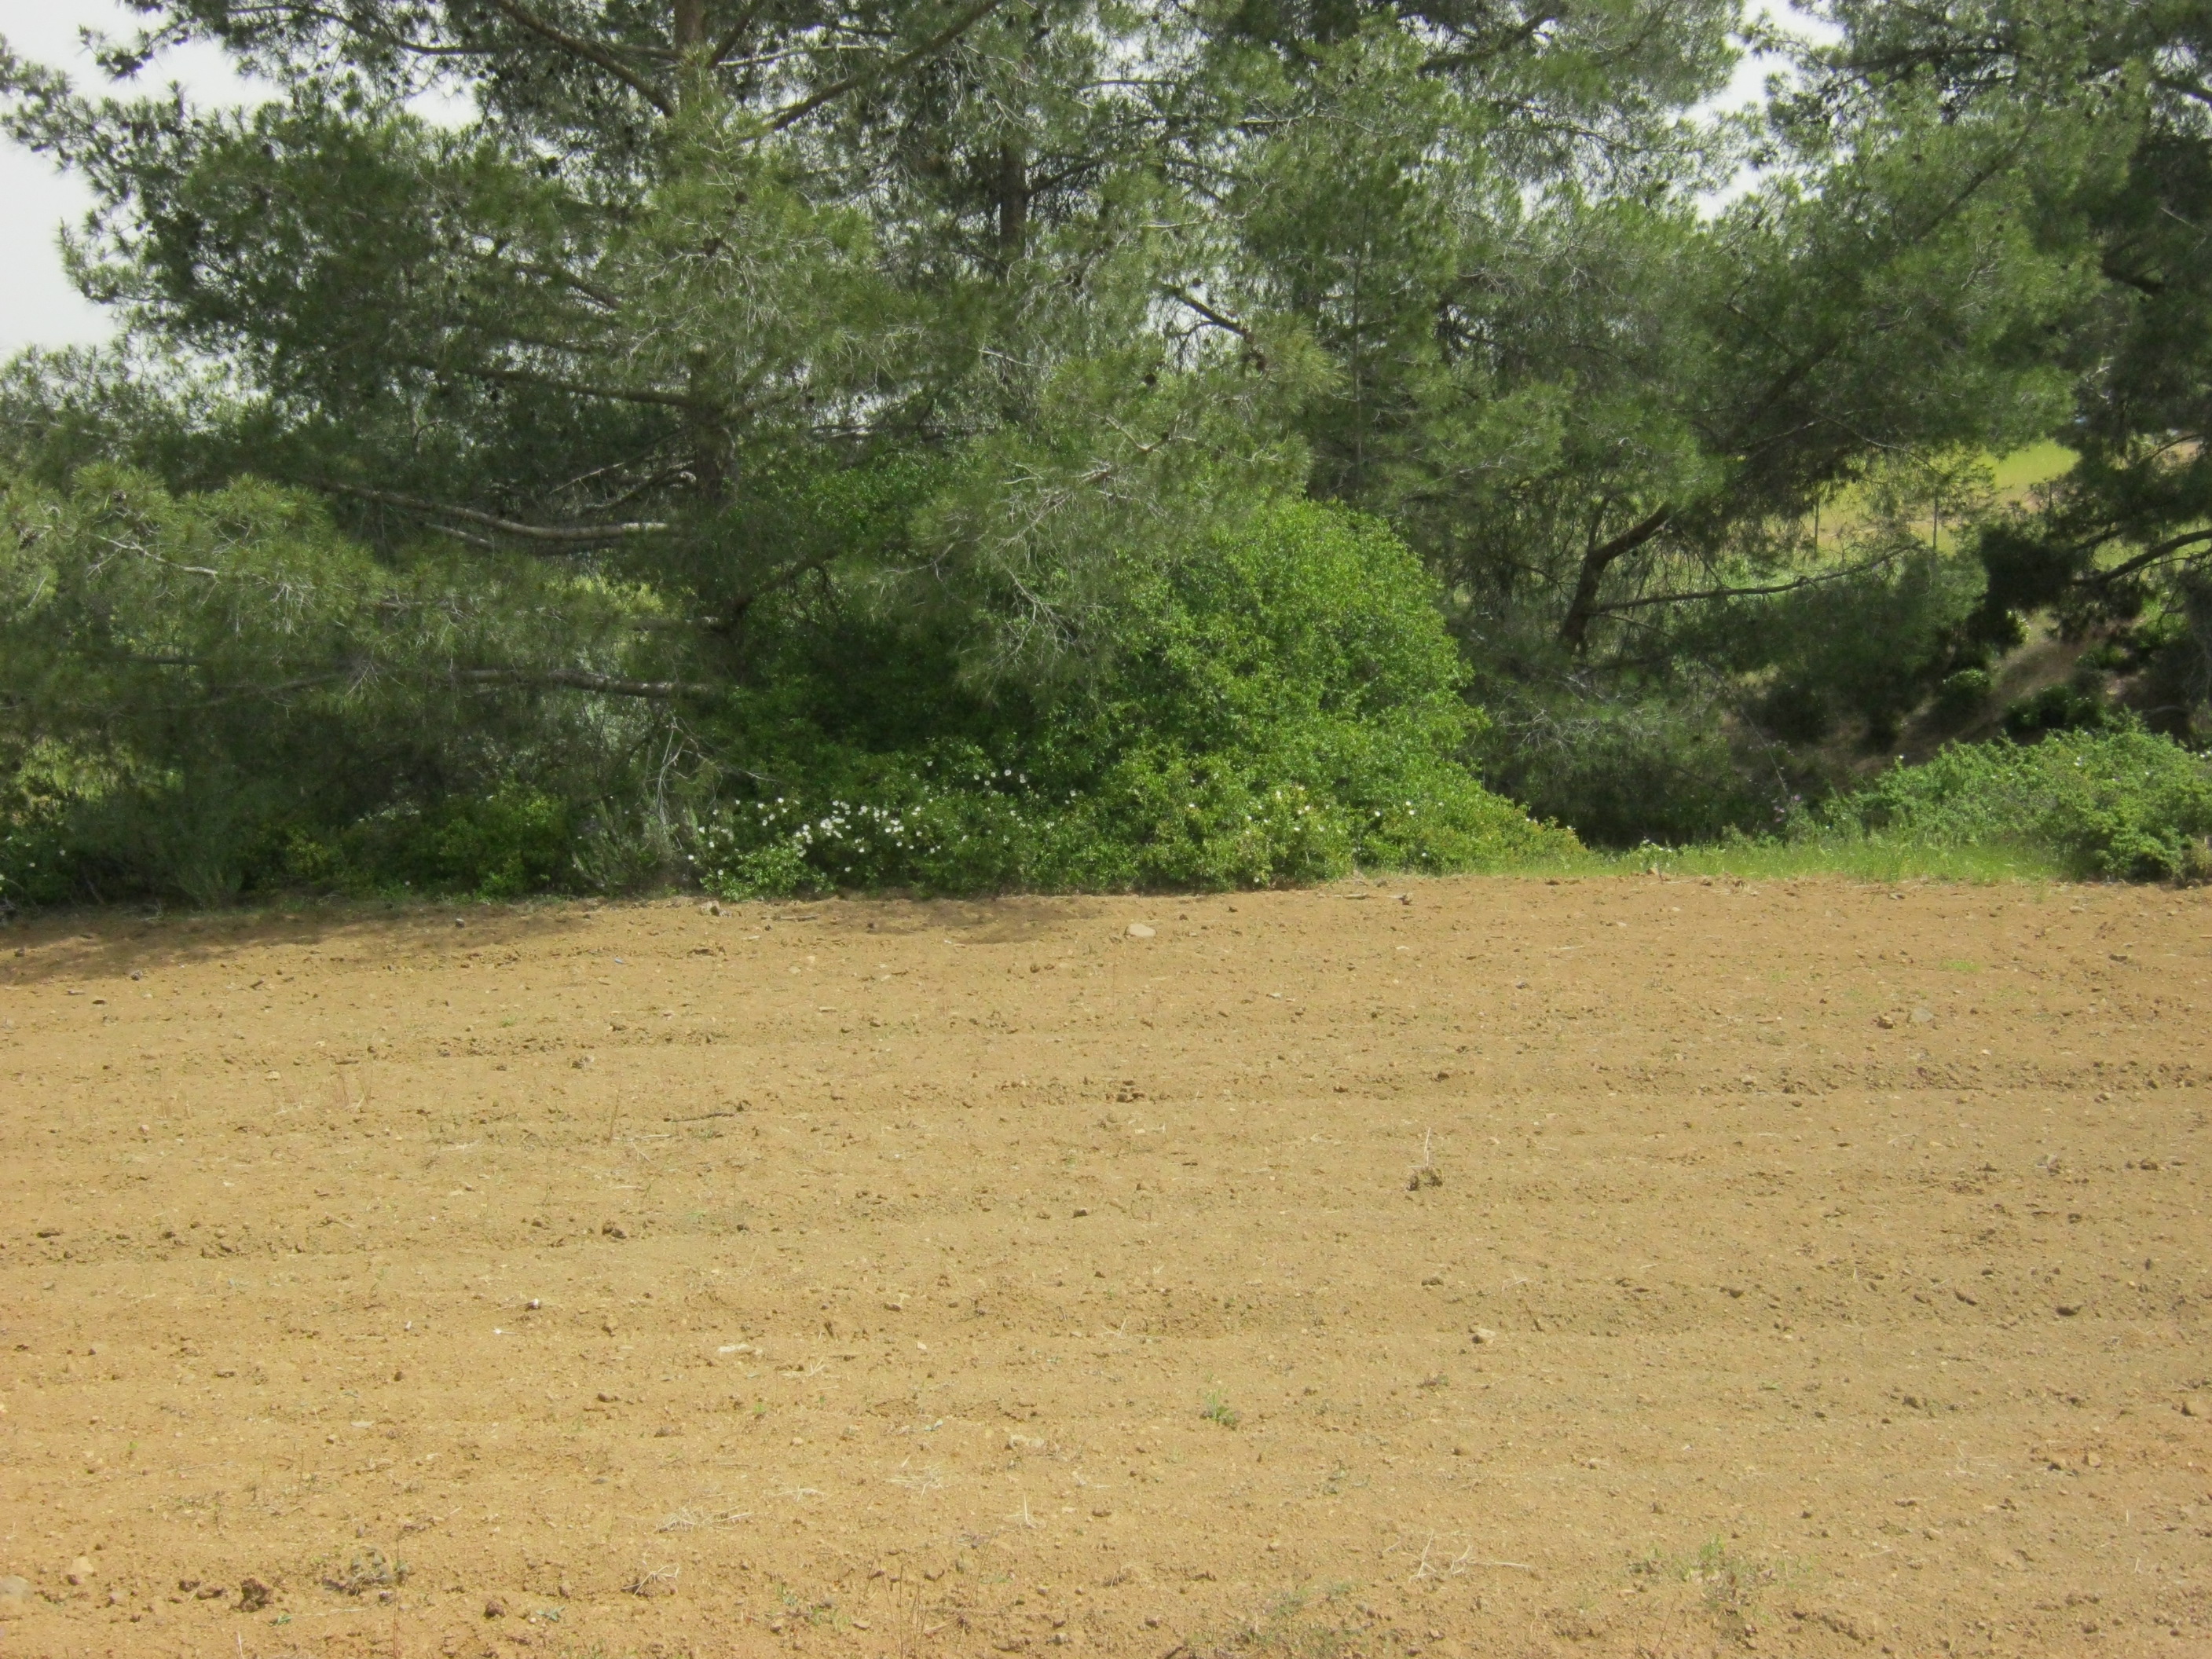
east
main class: Cropland
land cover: Other fruit trees and berries
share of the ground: < 10 %
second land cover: Other bare soil
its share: > 75 %
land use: Agriculture (excluding fallow land and kitchen gardens)
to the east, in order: Other fruit trees and berries; Other bare soil; Pine dominated coniferous woodland; Rivers and streams; Fences; Grassland without tree/shrub cover; Tracks; Grassland without tree/shrub cover; Pine dominated coniferous woodland; Shrubland with sparse tree cover; Paved roads, cycling and walking lanes; Artificial constructions in urban areas; Grassland without tree/shrub cover; Pine dominated coniferous woodland; Rivers and streams; Pine dominated coniferous woodland; Rivers and streams; Pine dominated coniferous woodland; Shrubland without tree cover
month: April
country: CY
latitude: 34.9653
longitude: 33.2819
